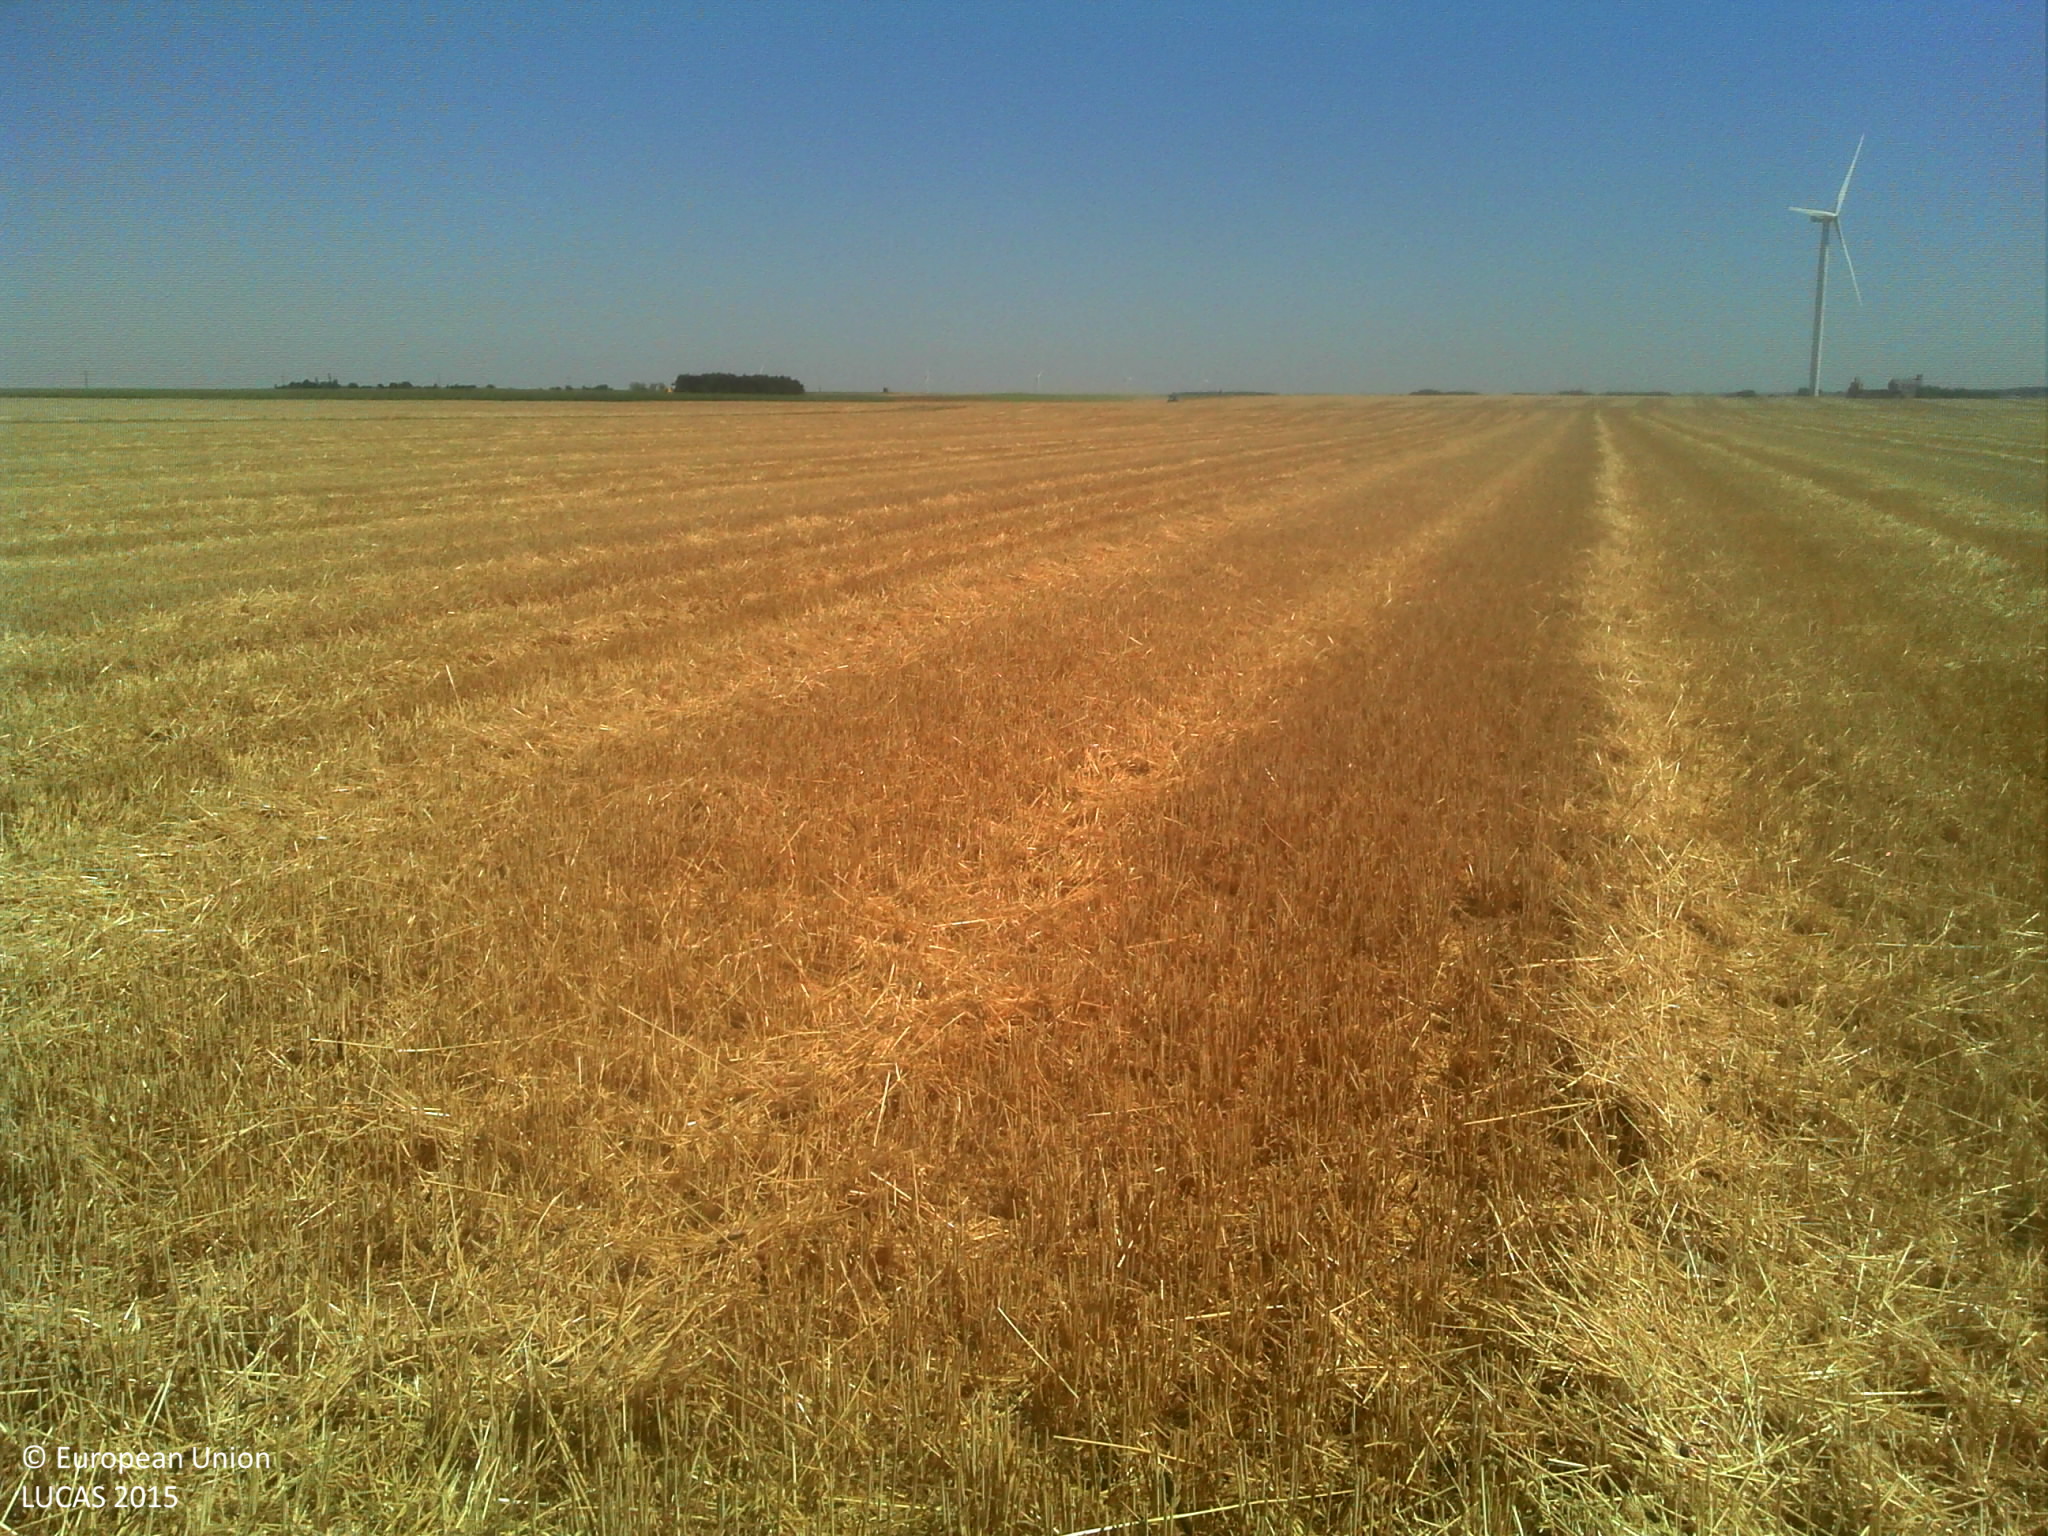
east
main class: Cropland
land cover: Durum wheat
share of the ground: > 75 %
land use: Agriculture (excluding fallow land and kitchen gardens)
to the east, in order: Durum wheat; Grassland without tree/shrub cover; Durum wheat
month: July
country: FR
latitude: 47.9194
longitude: 1.3524
